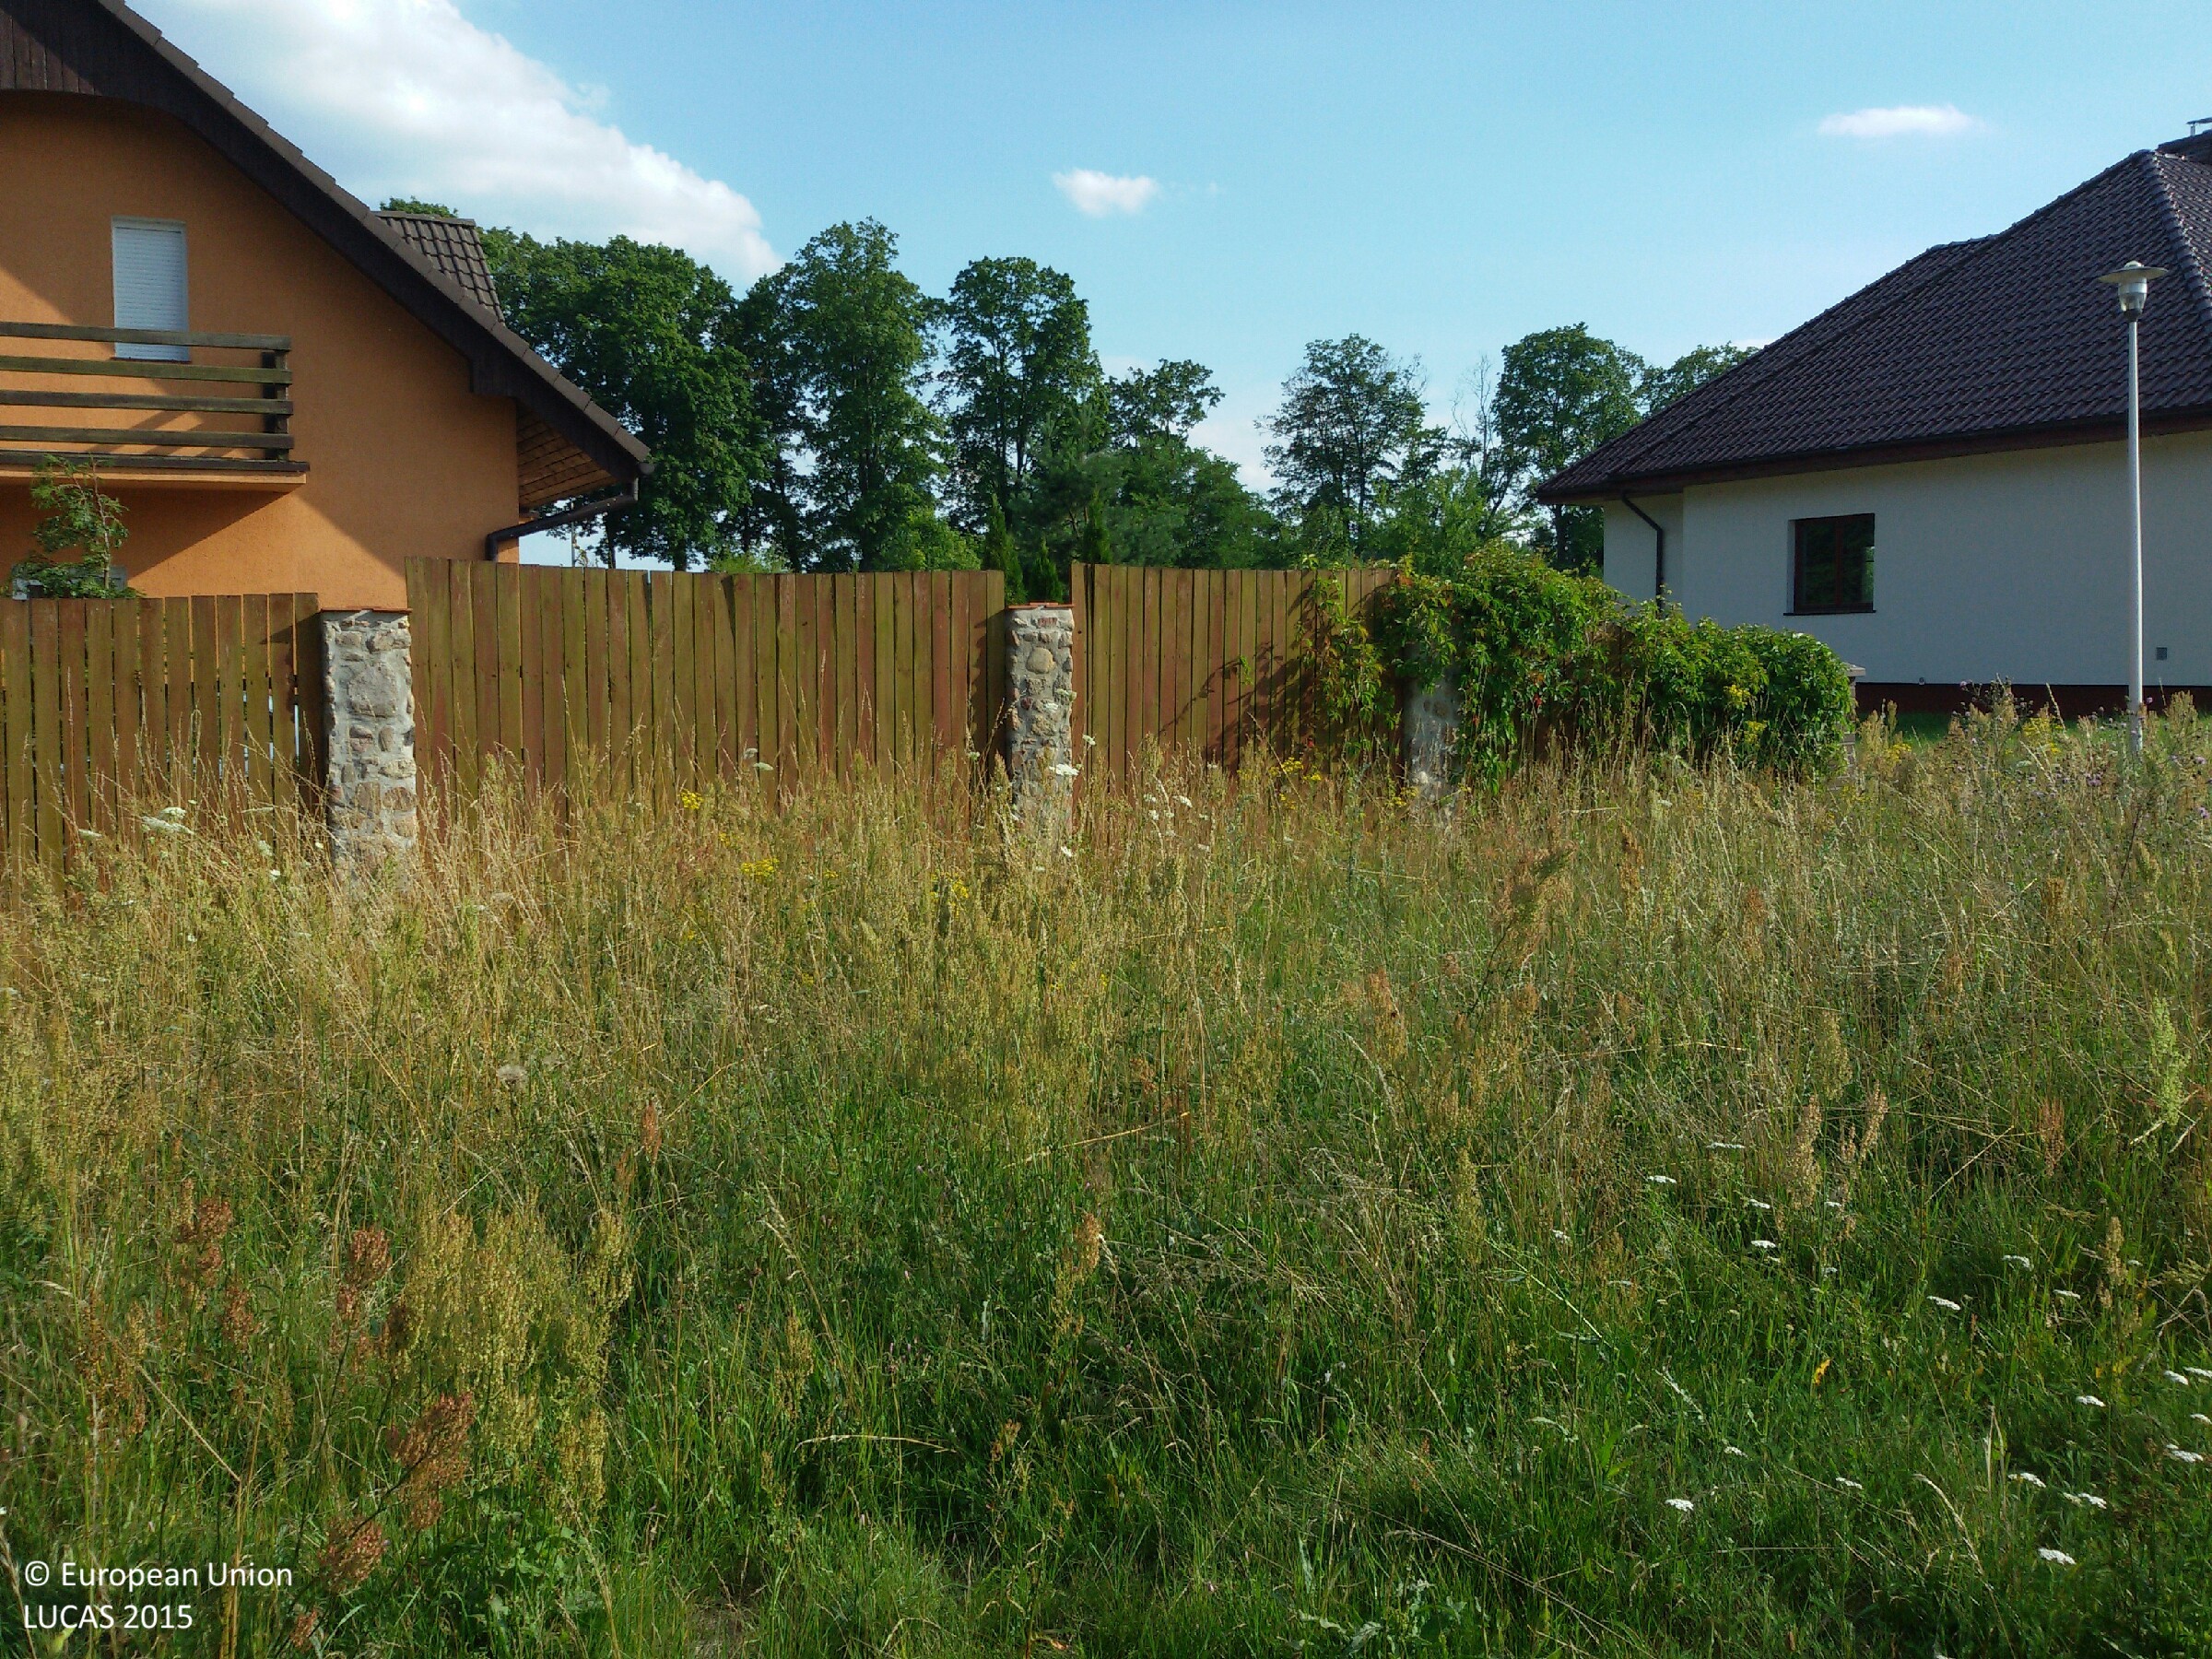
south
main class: Grassland
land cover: Spontaneously vegetated surfaces
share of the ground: > 75 %
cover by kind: herbaceous plants 100 %
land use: Construction
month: July
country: PL
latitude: 53.2118
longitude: 15.7393
